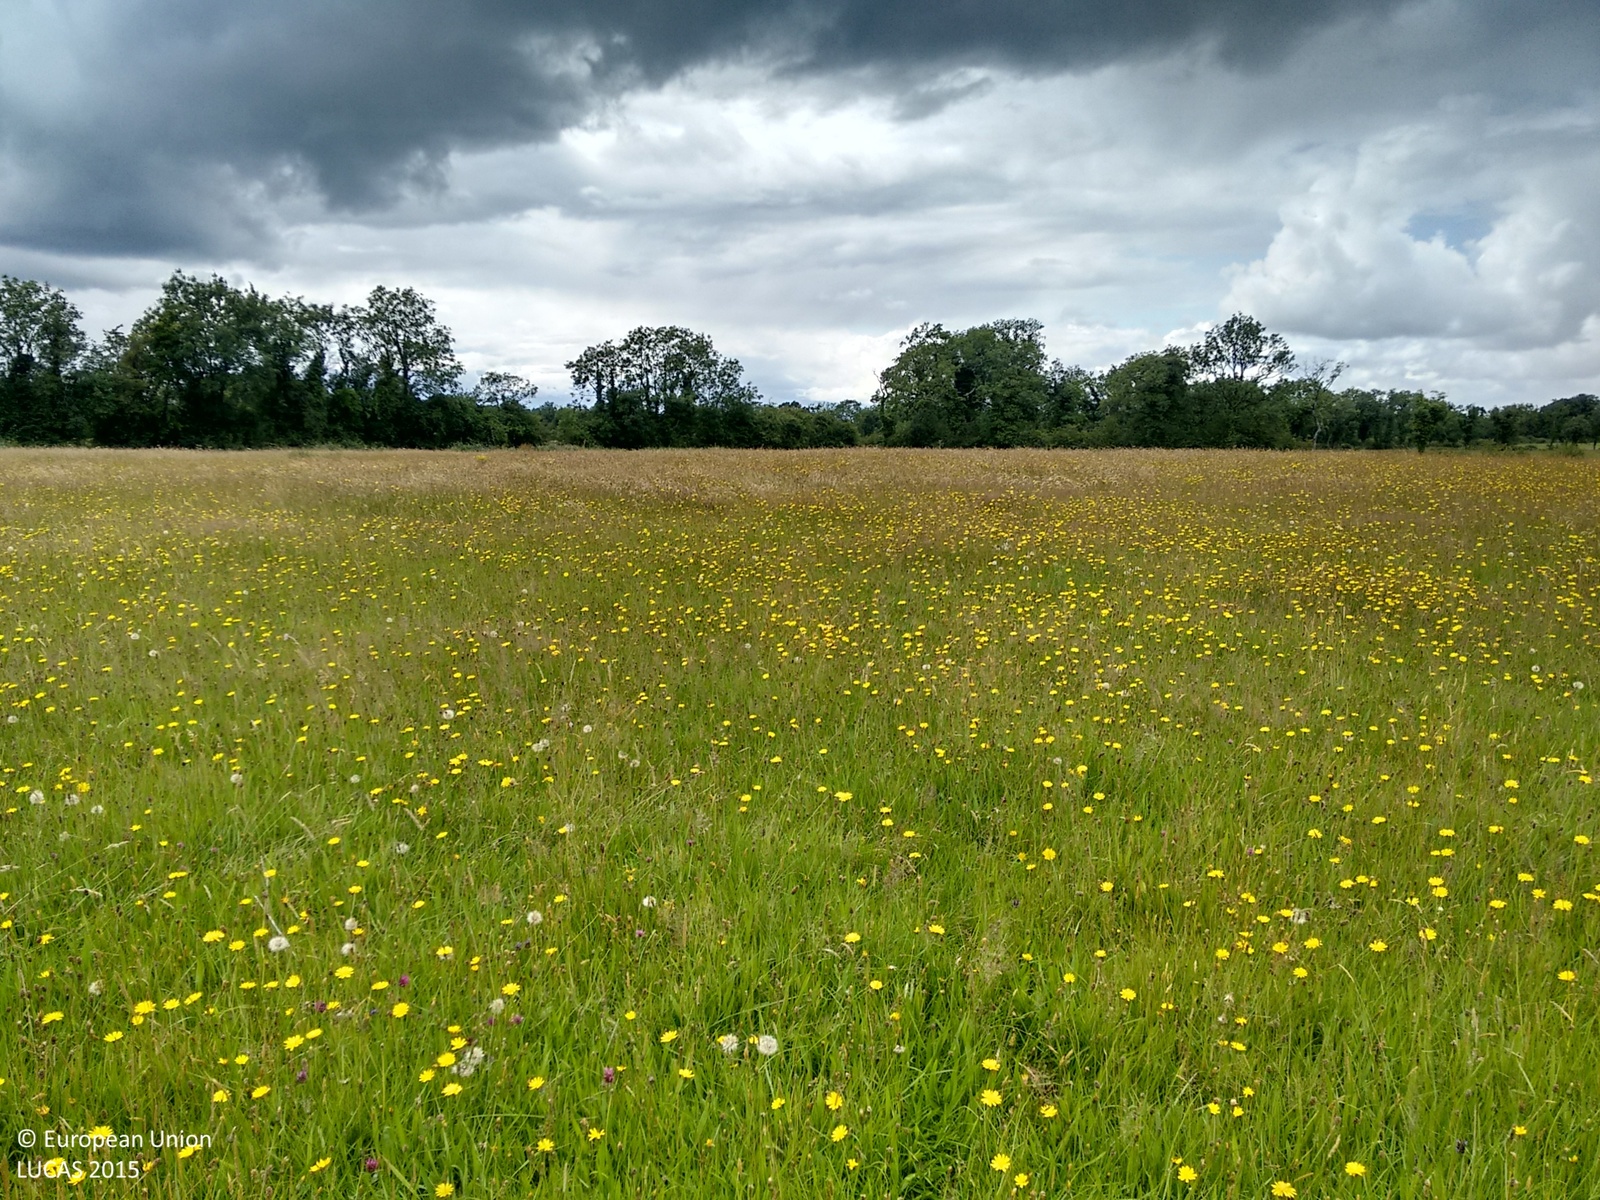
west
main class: Grassland
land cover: Grassland without tree/shrub cover
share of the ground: > 75 %
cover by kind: herbaceous plants 95 %, shrubs 5 %
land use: Agriculture (excluding fallow land and kitchen gardens)
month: July
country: IE
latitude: 53.7194
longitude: -7.7287
